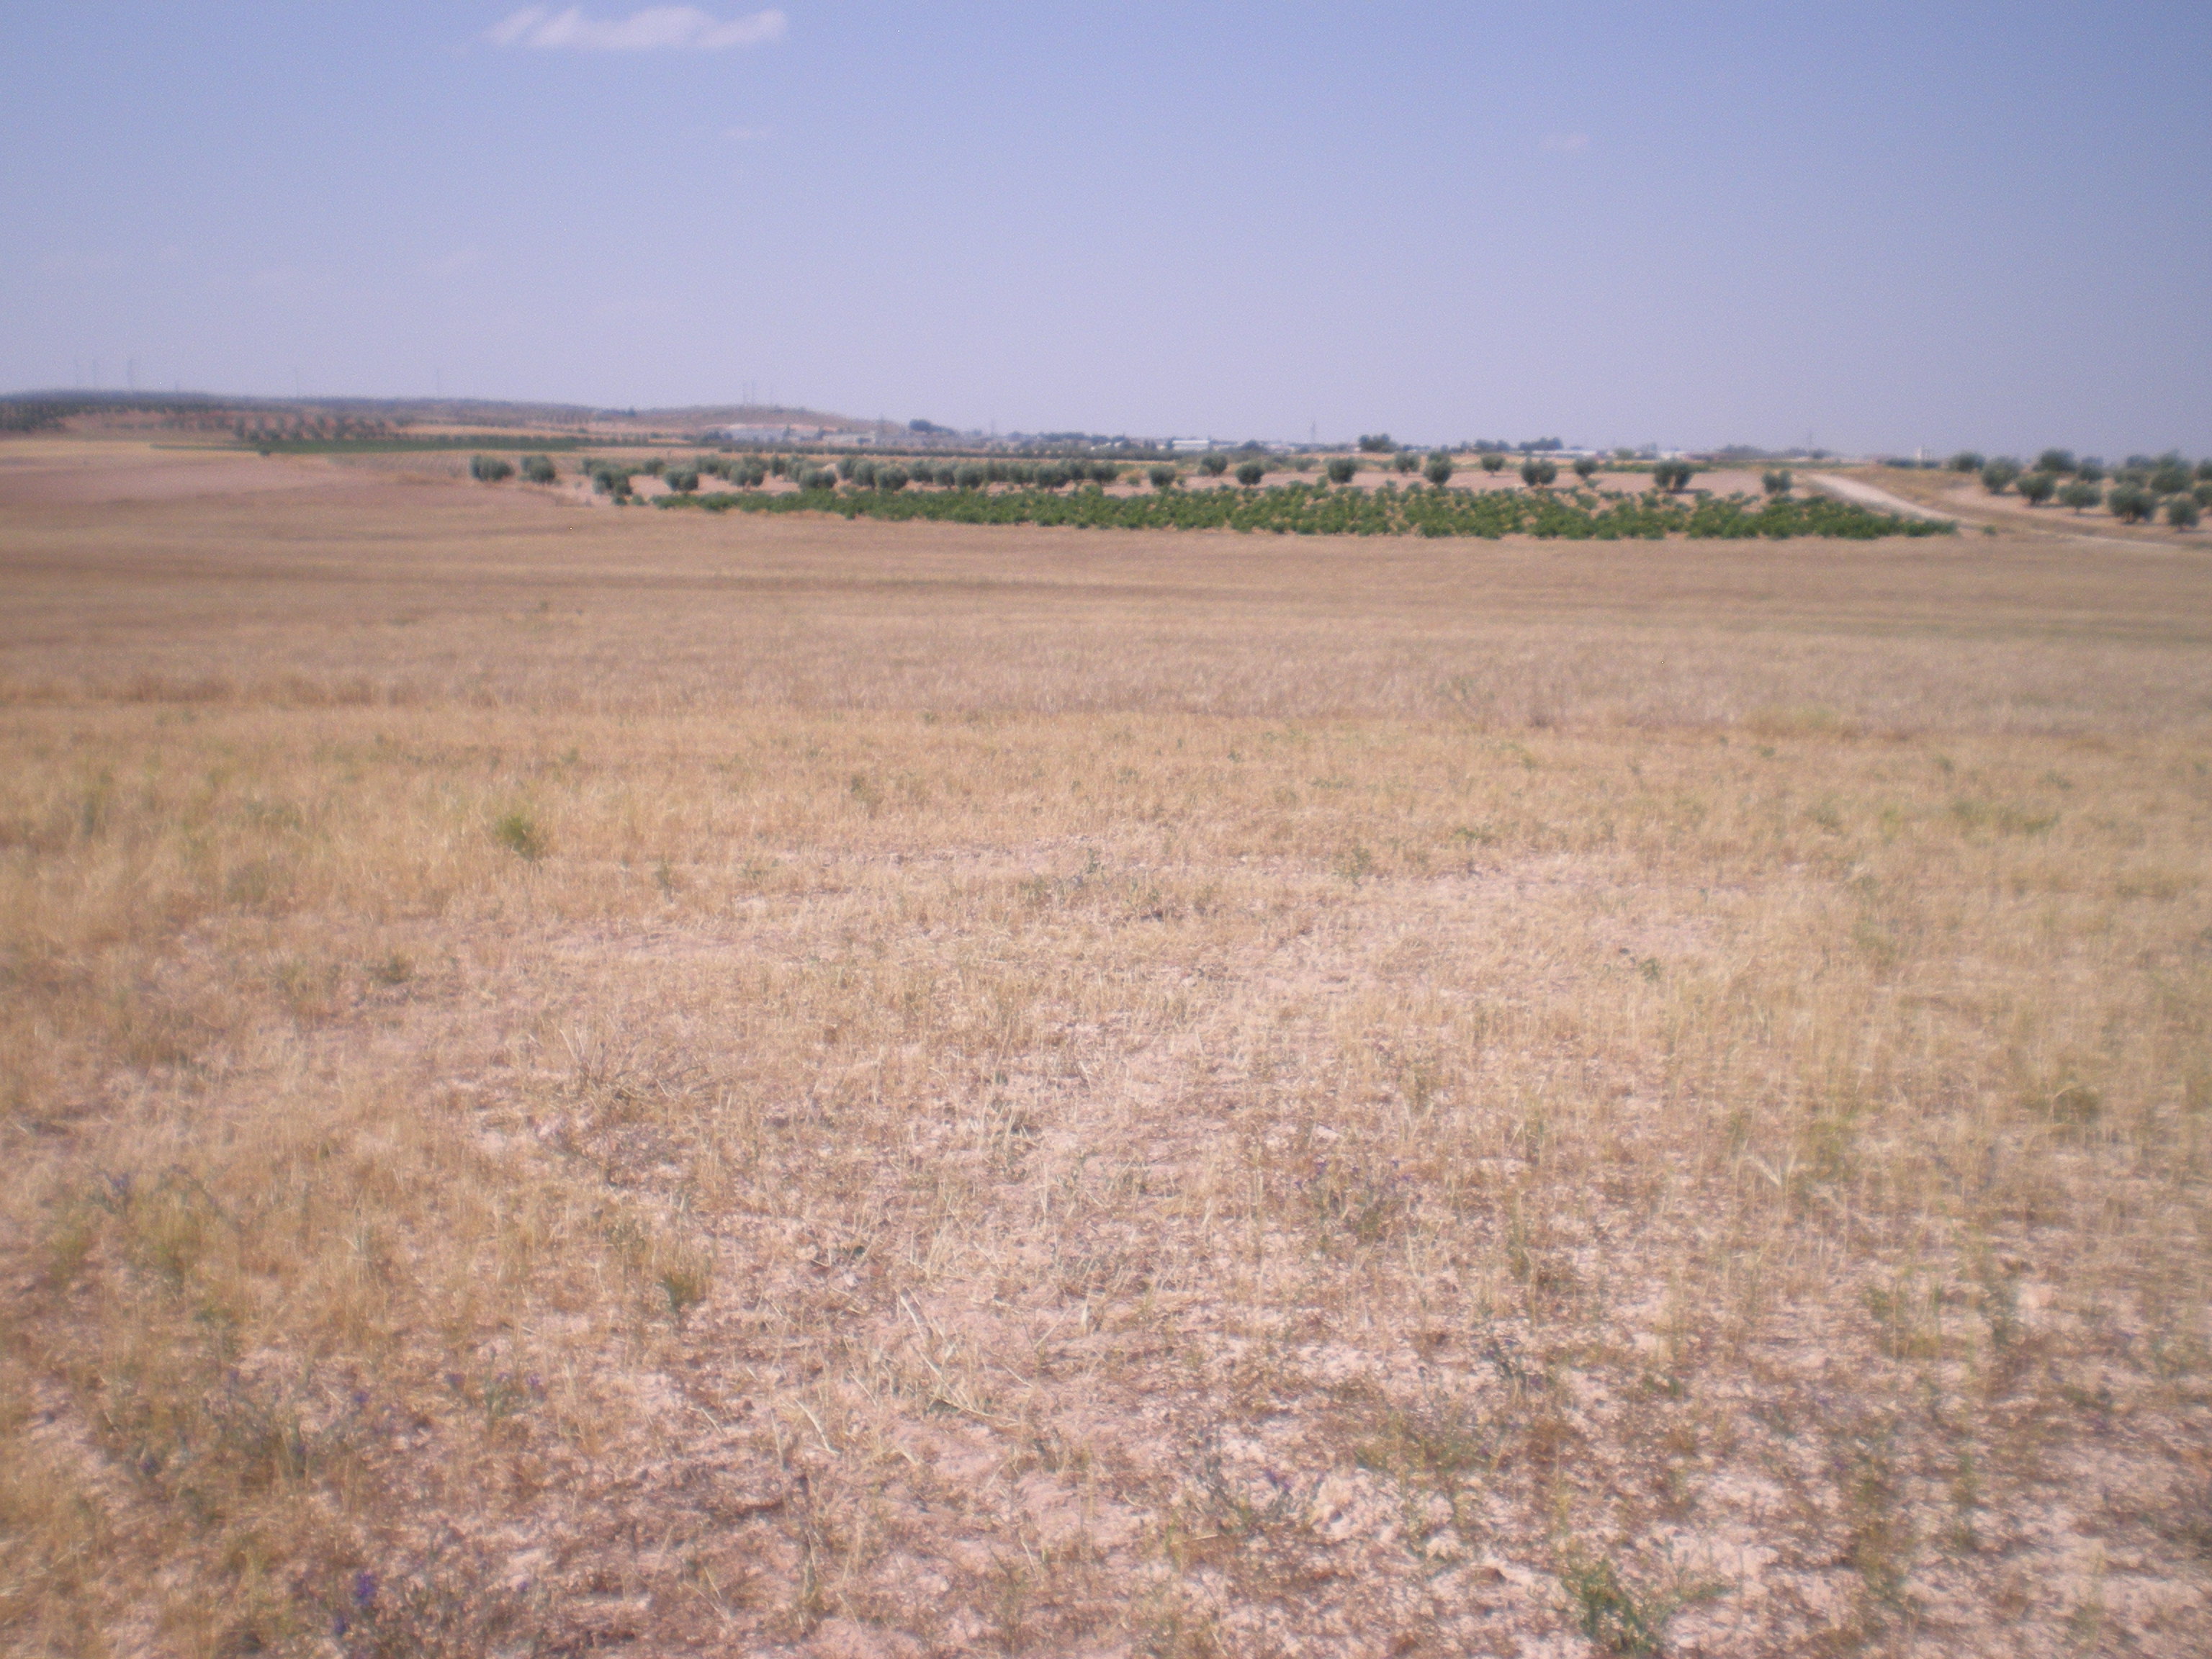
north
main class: Cropland
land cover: Barley
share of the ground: < 10 %
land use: Agriculture (excluding fallow land and kitchen gardens)
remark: Harvested field
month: June
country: ES
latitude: 39.5880
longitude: -3.3541
